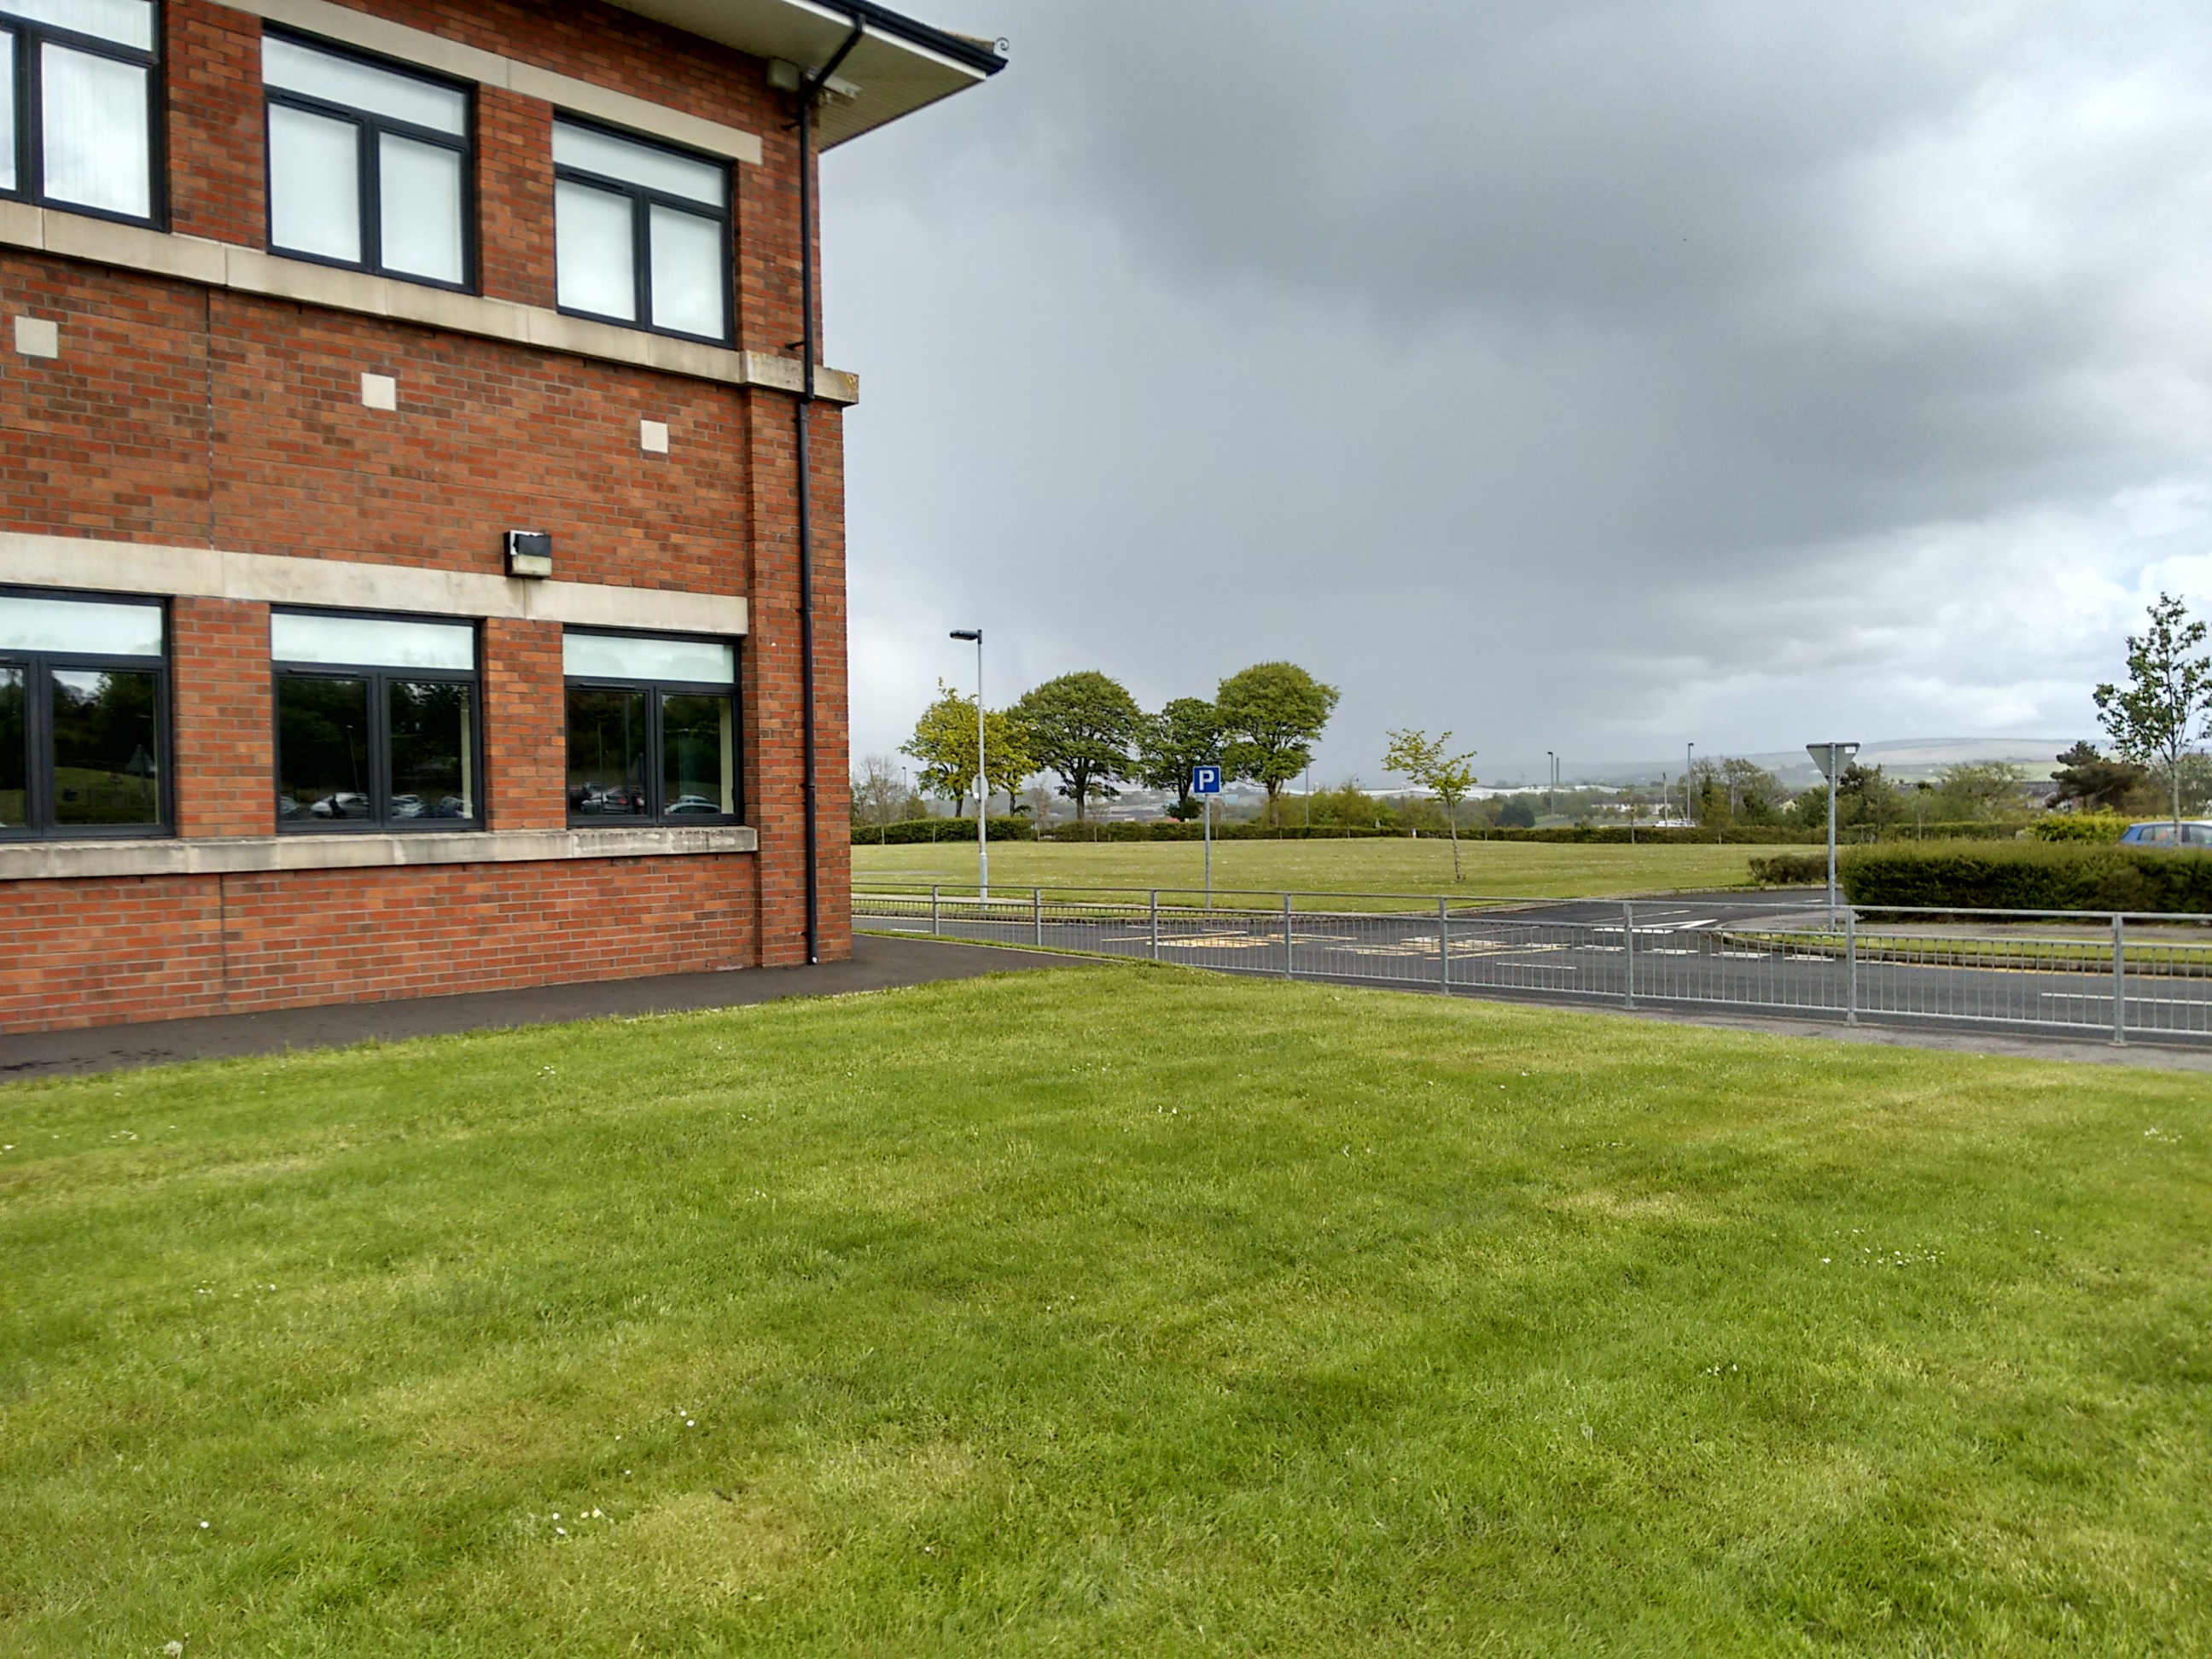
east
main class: Grassland
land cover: Grassland without tree/shrub cover
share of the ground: > 75 %
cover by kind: herbaceous plants 100 %
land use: Community services
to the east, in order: Grassland without tree/shrub cover; Artificial constructions in urban areas; Single bushes/trees; Grassland without tree/shrub cover; Lines of trees; Managed hedges; Fences; Grassland without tree/shrub cover; Paved roads, cycling and walking lanes; Artificial constructions; Single bushes/trees; Grassland without tree/shrub cover
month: May
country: GB
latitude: 55.0382
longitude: -7.2811
